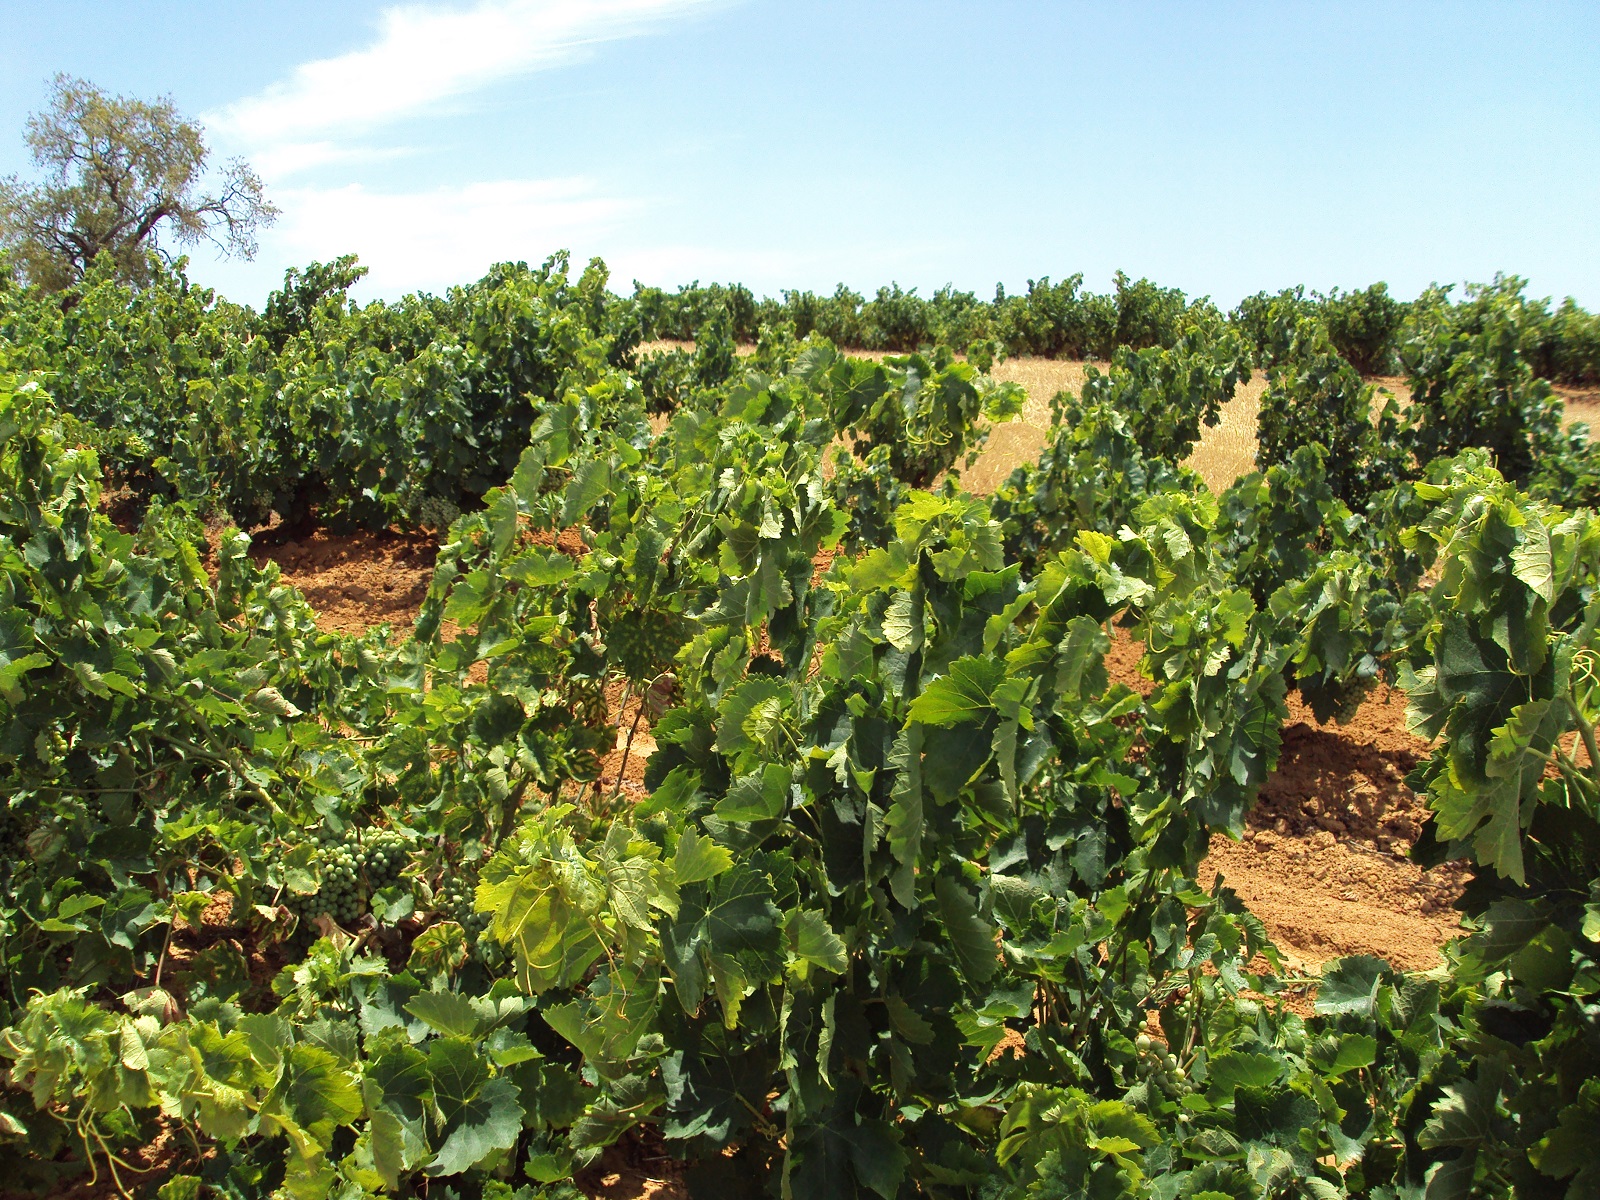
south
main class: Cropland
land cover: Vineyards
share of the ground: > 75 %
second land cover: Other bare soil
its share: > 75 %
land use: Agriculture (excluding fallow land and kitchen gardens)
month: June
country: ES
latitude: 37.3493
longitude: -6.5942
